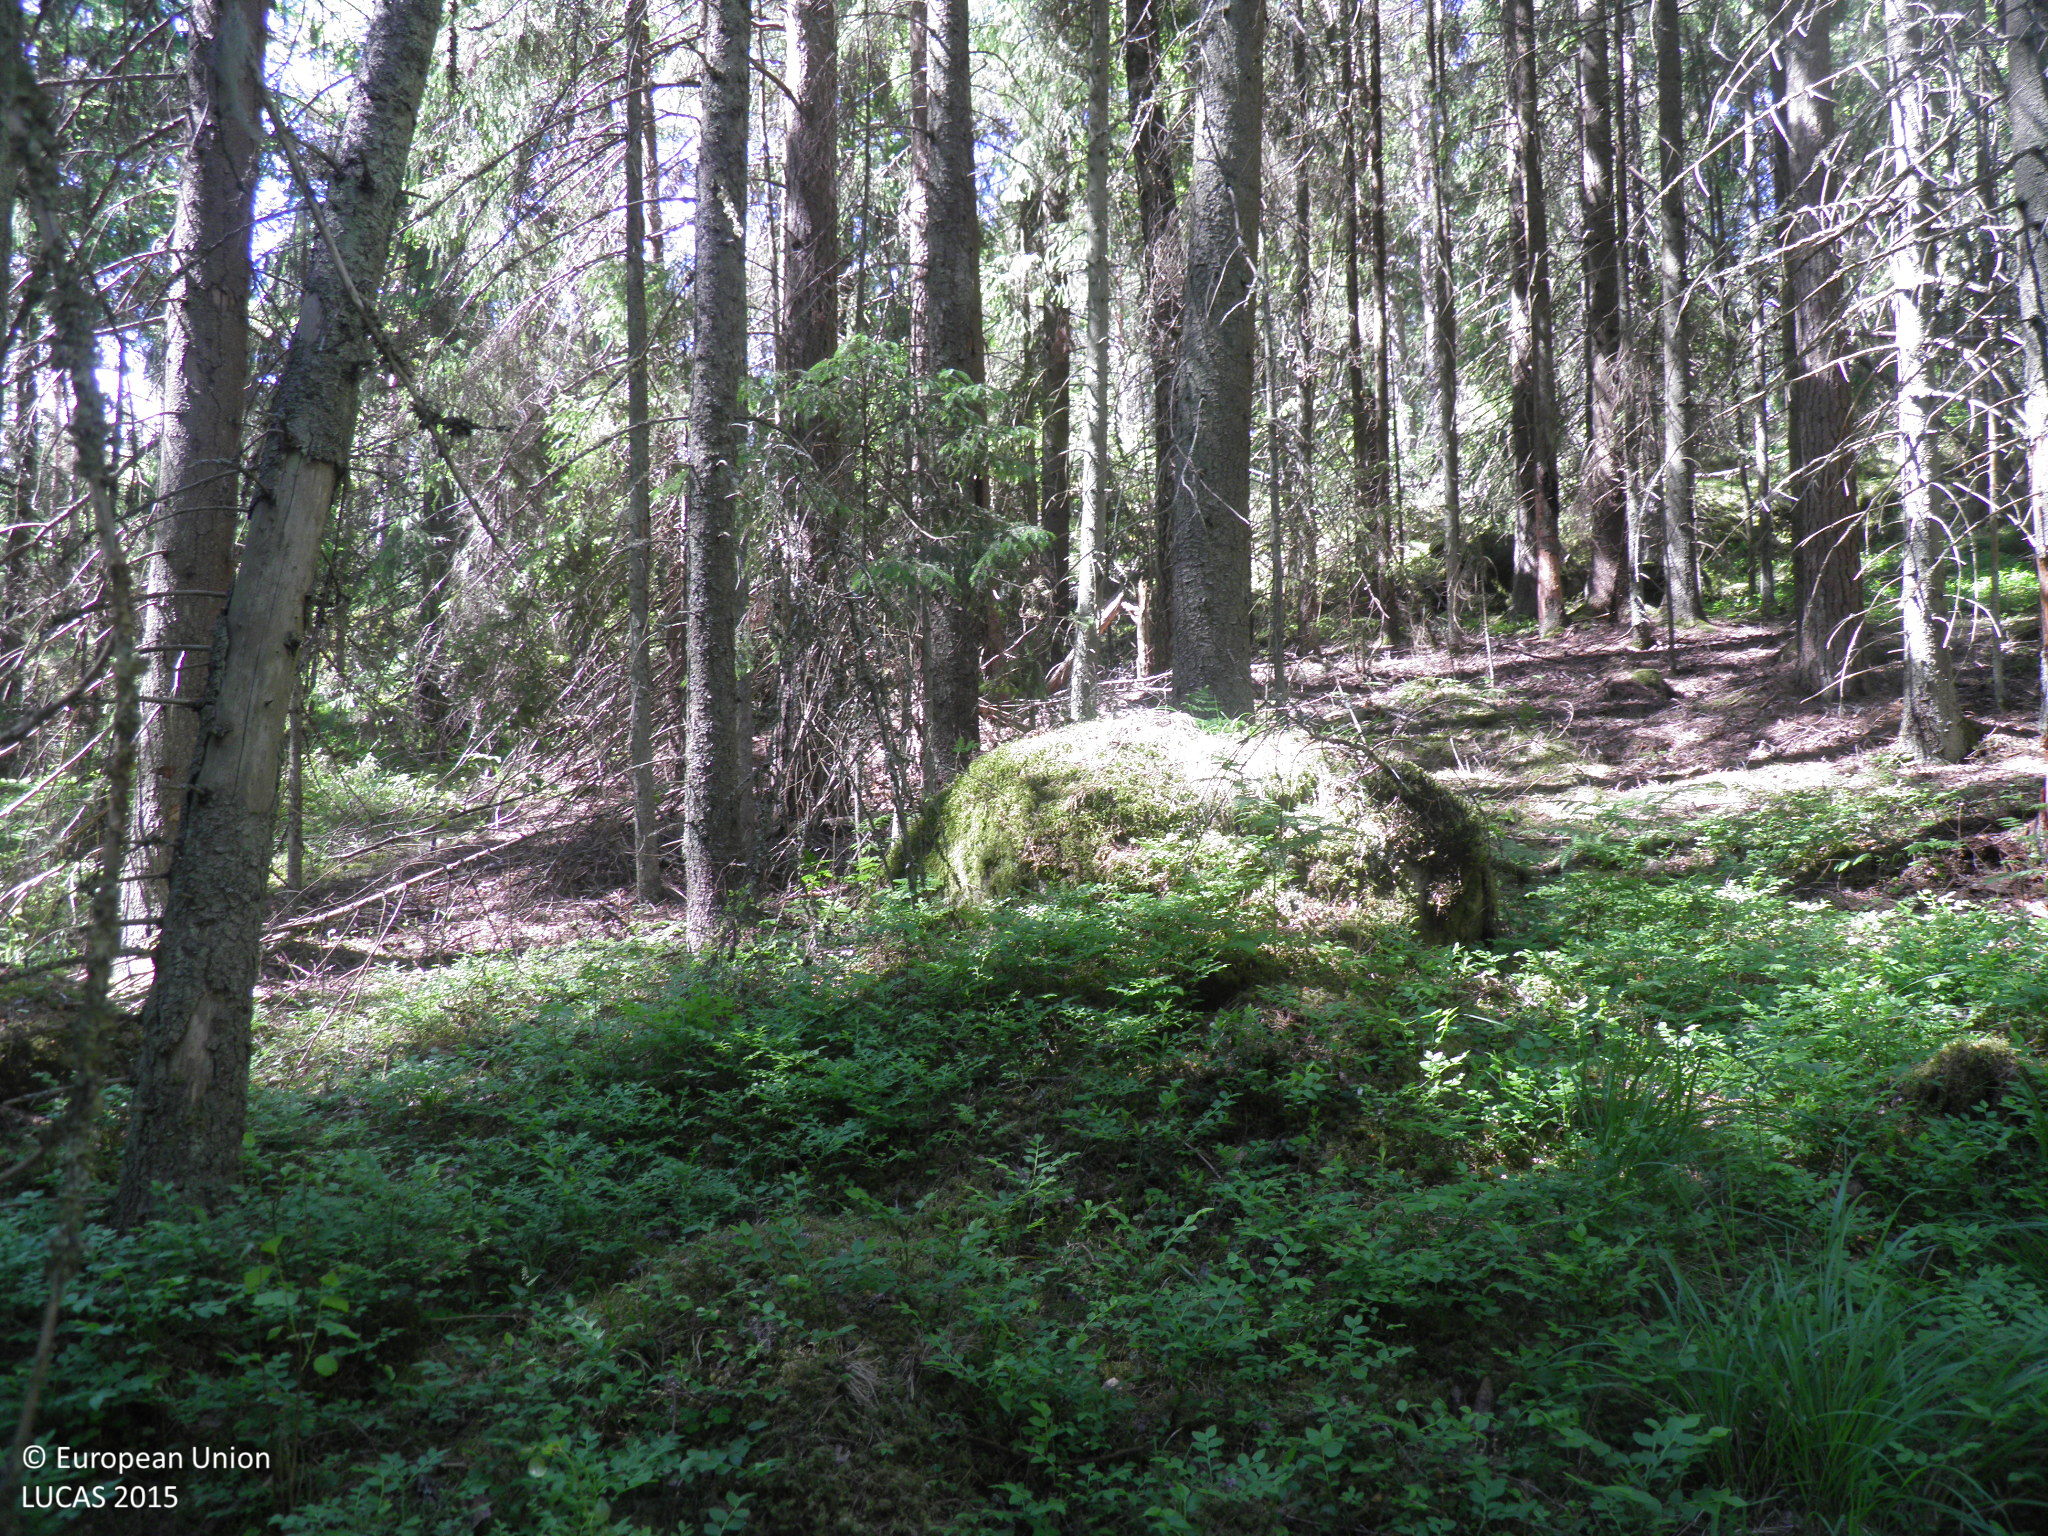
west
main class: Woodland
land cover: Spruce dominated coniferous woodland
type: hemiboreal forest and nemoral coniferous forest and mixed broadleaved-coniferous forest
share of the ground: > 75 %
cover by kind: coniferous forest trees 75 %, broadleaved forest trees 10 %, shrubs 5 %, herbaceous plants 5 %, lichens and mosses 5 %
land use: Semi-natural and natural areas not in use
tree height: > 5 m
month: June
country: FI
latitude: 60.4388
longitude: 22.5551
